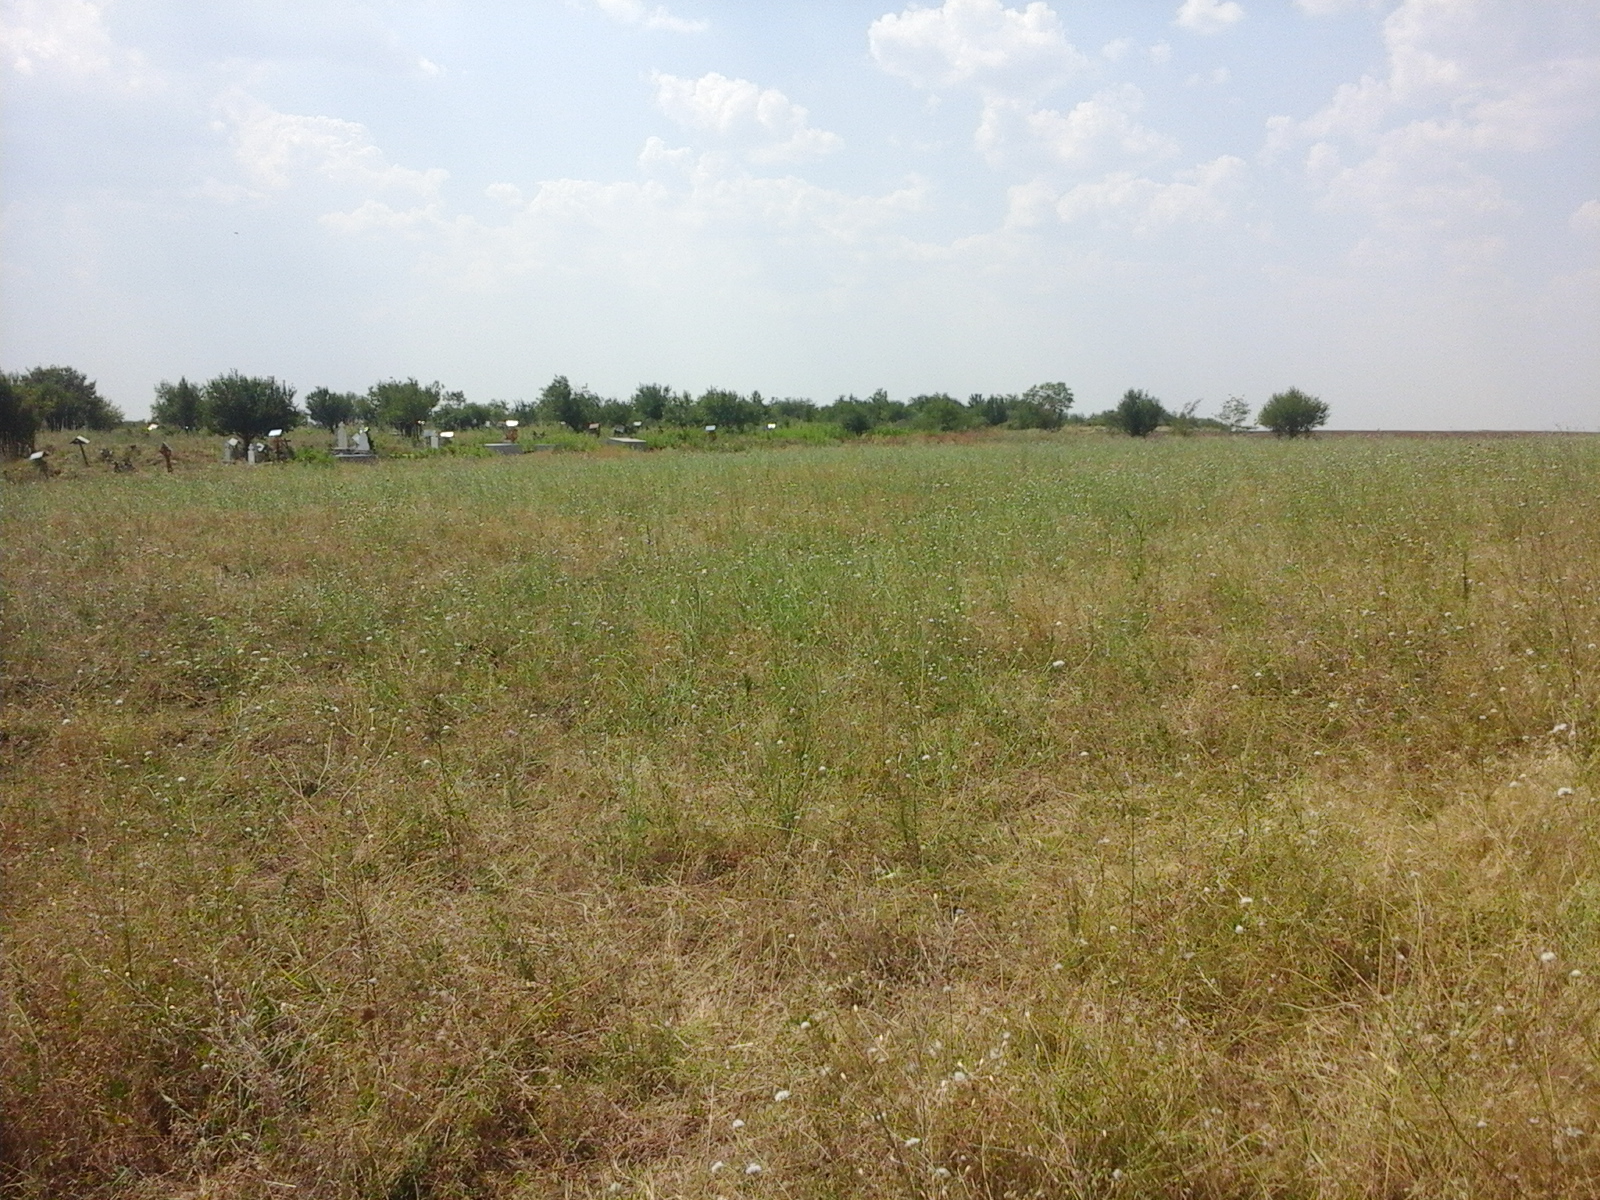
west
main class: Grassland
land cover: Grassland without tree/shrub cover
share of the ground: > 75 %
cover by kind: herbaceous plants 100 %
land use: Agriculture (excluding fallow land and kitchen gardens)
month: August
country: RO
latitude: 44.1975
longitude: 23.4763
